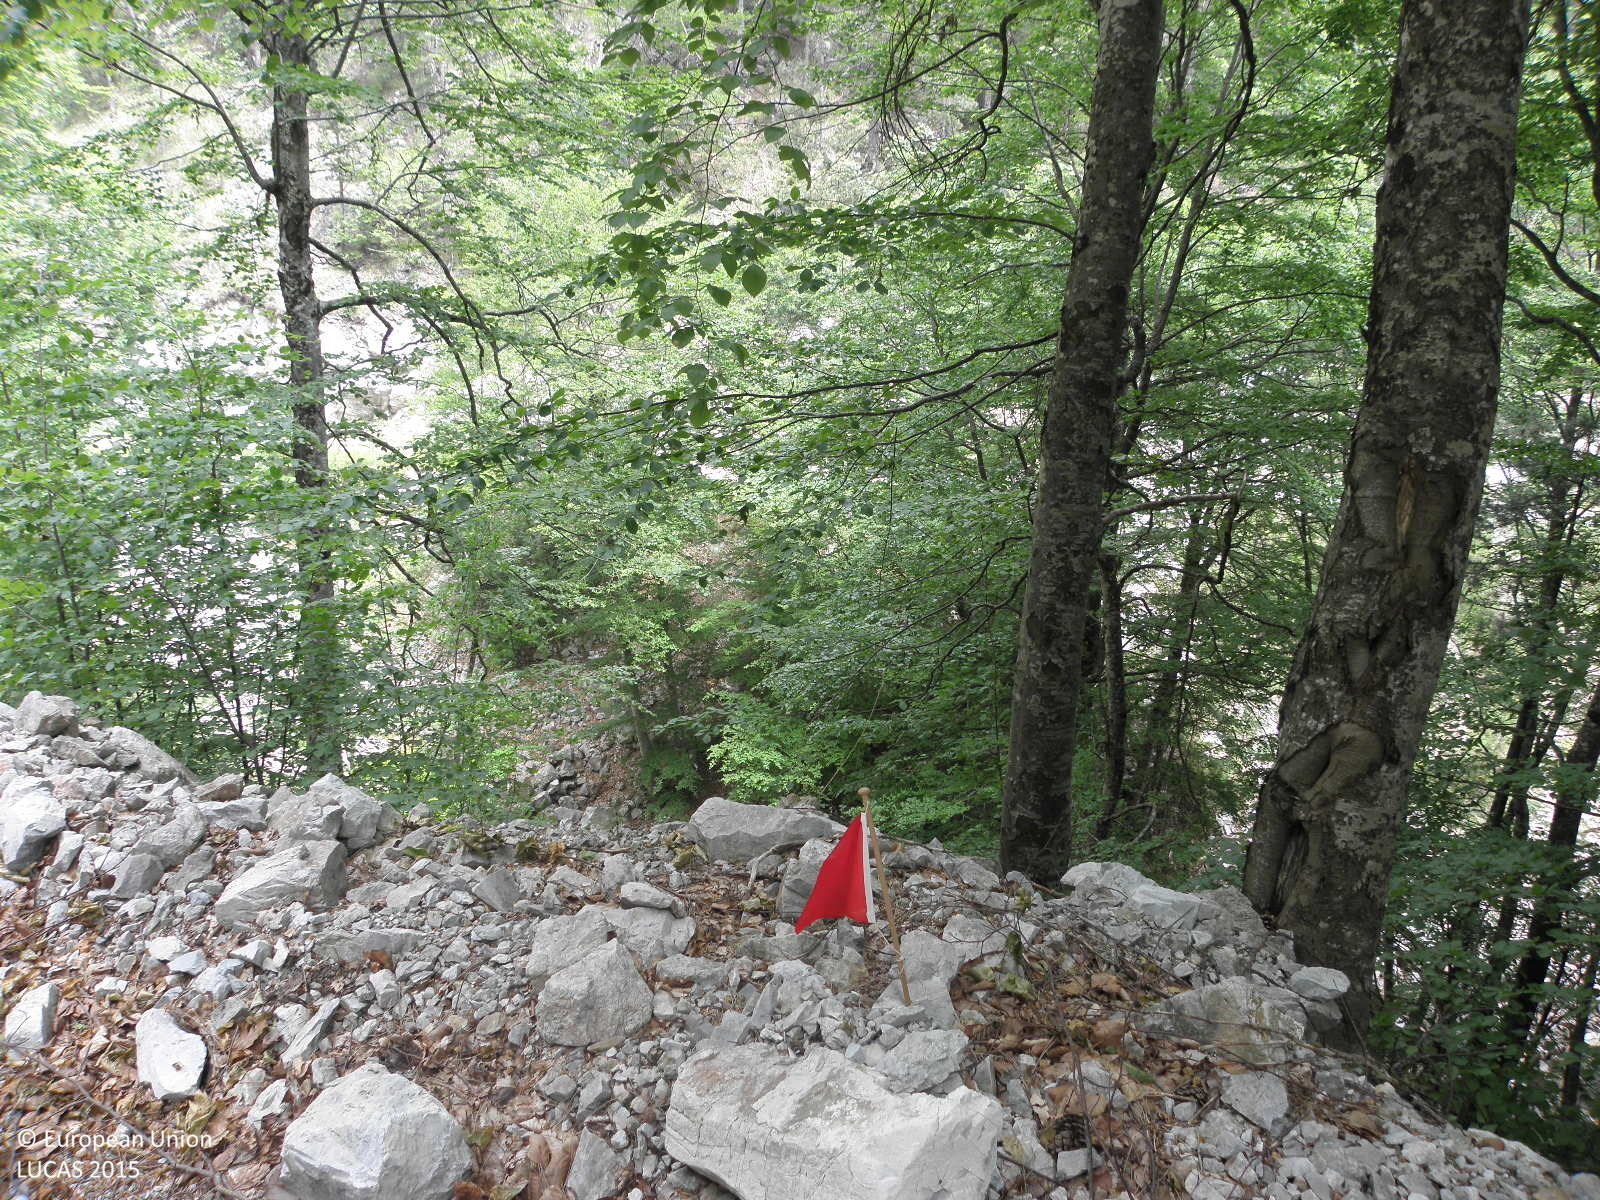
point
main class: Woodland
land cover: Broadleaved woodland
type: beech forest
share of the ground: > 75 %
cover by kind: broadleaved forest trees 100 %
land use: Forestry
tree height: > 5 m
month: May
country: GR
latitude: 40.0523
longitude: 22.4795
